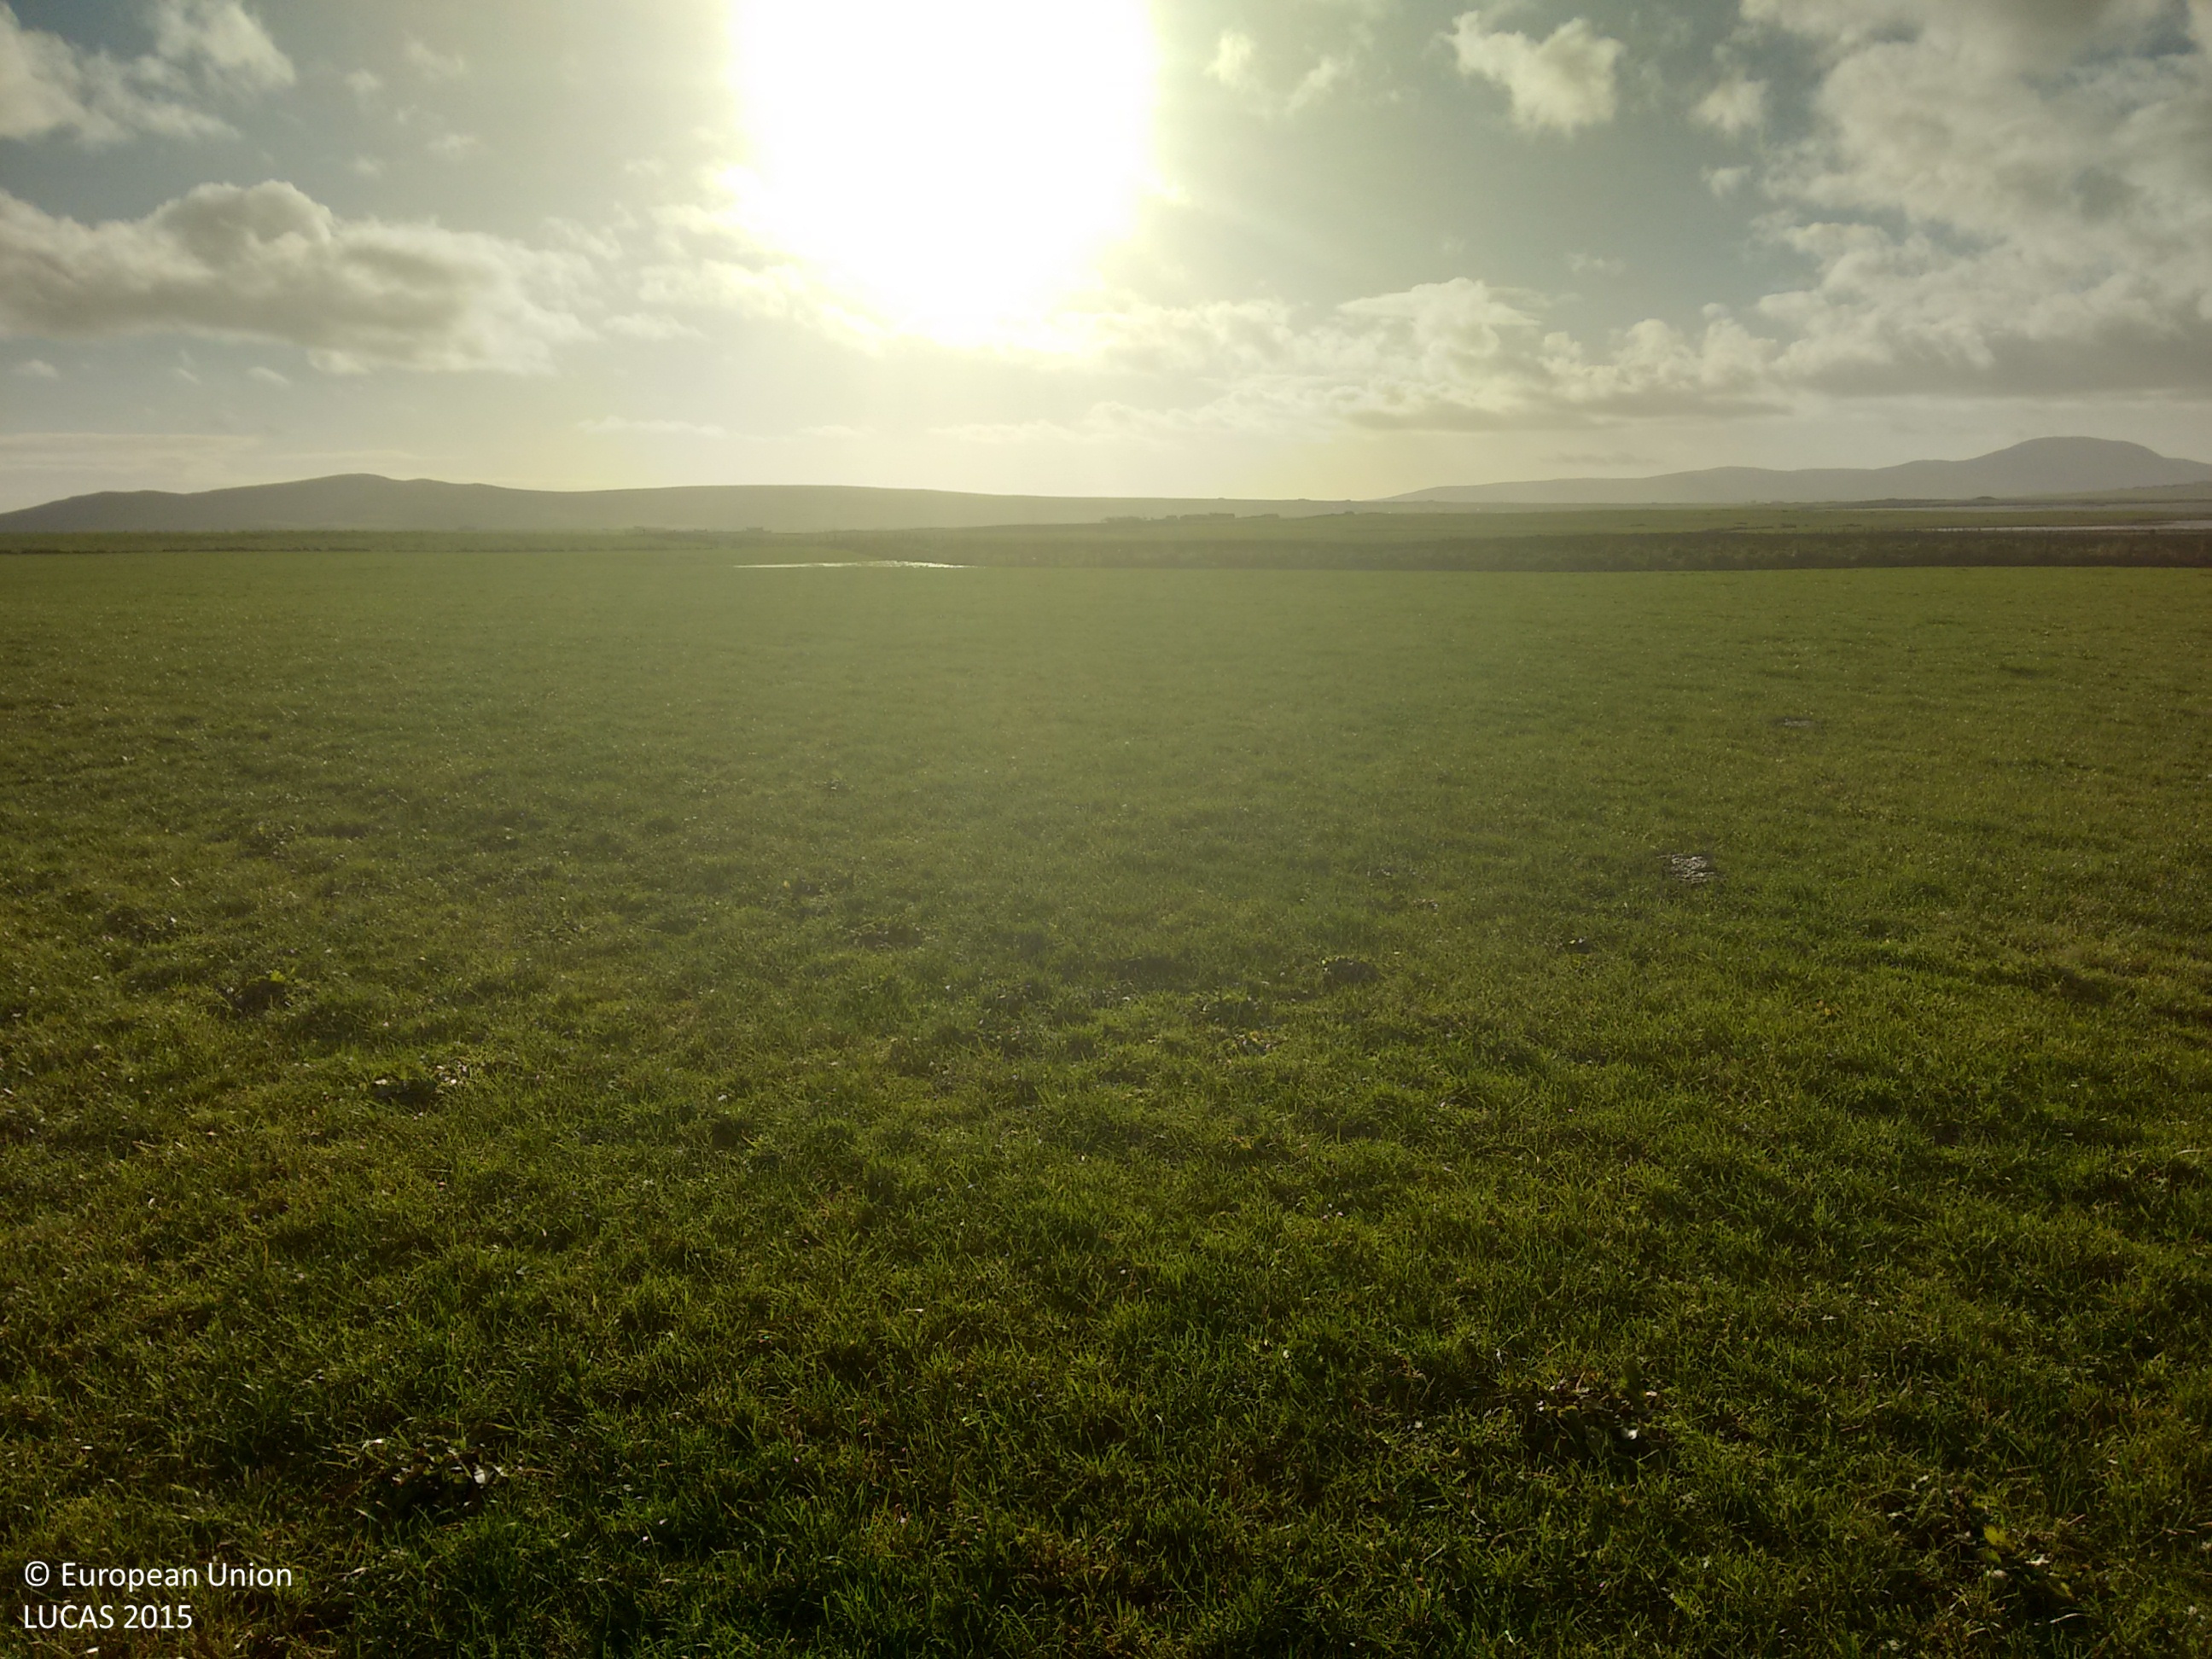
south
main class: Grassland
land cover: Grassland without tree/shrub cover
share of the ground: > 75 %
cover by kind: herbaceous plants 100 %
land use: Agriculture (excluding fallow land and kitchen gardens)
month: November
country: GB
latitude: 59.0256
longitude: -3.2083
